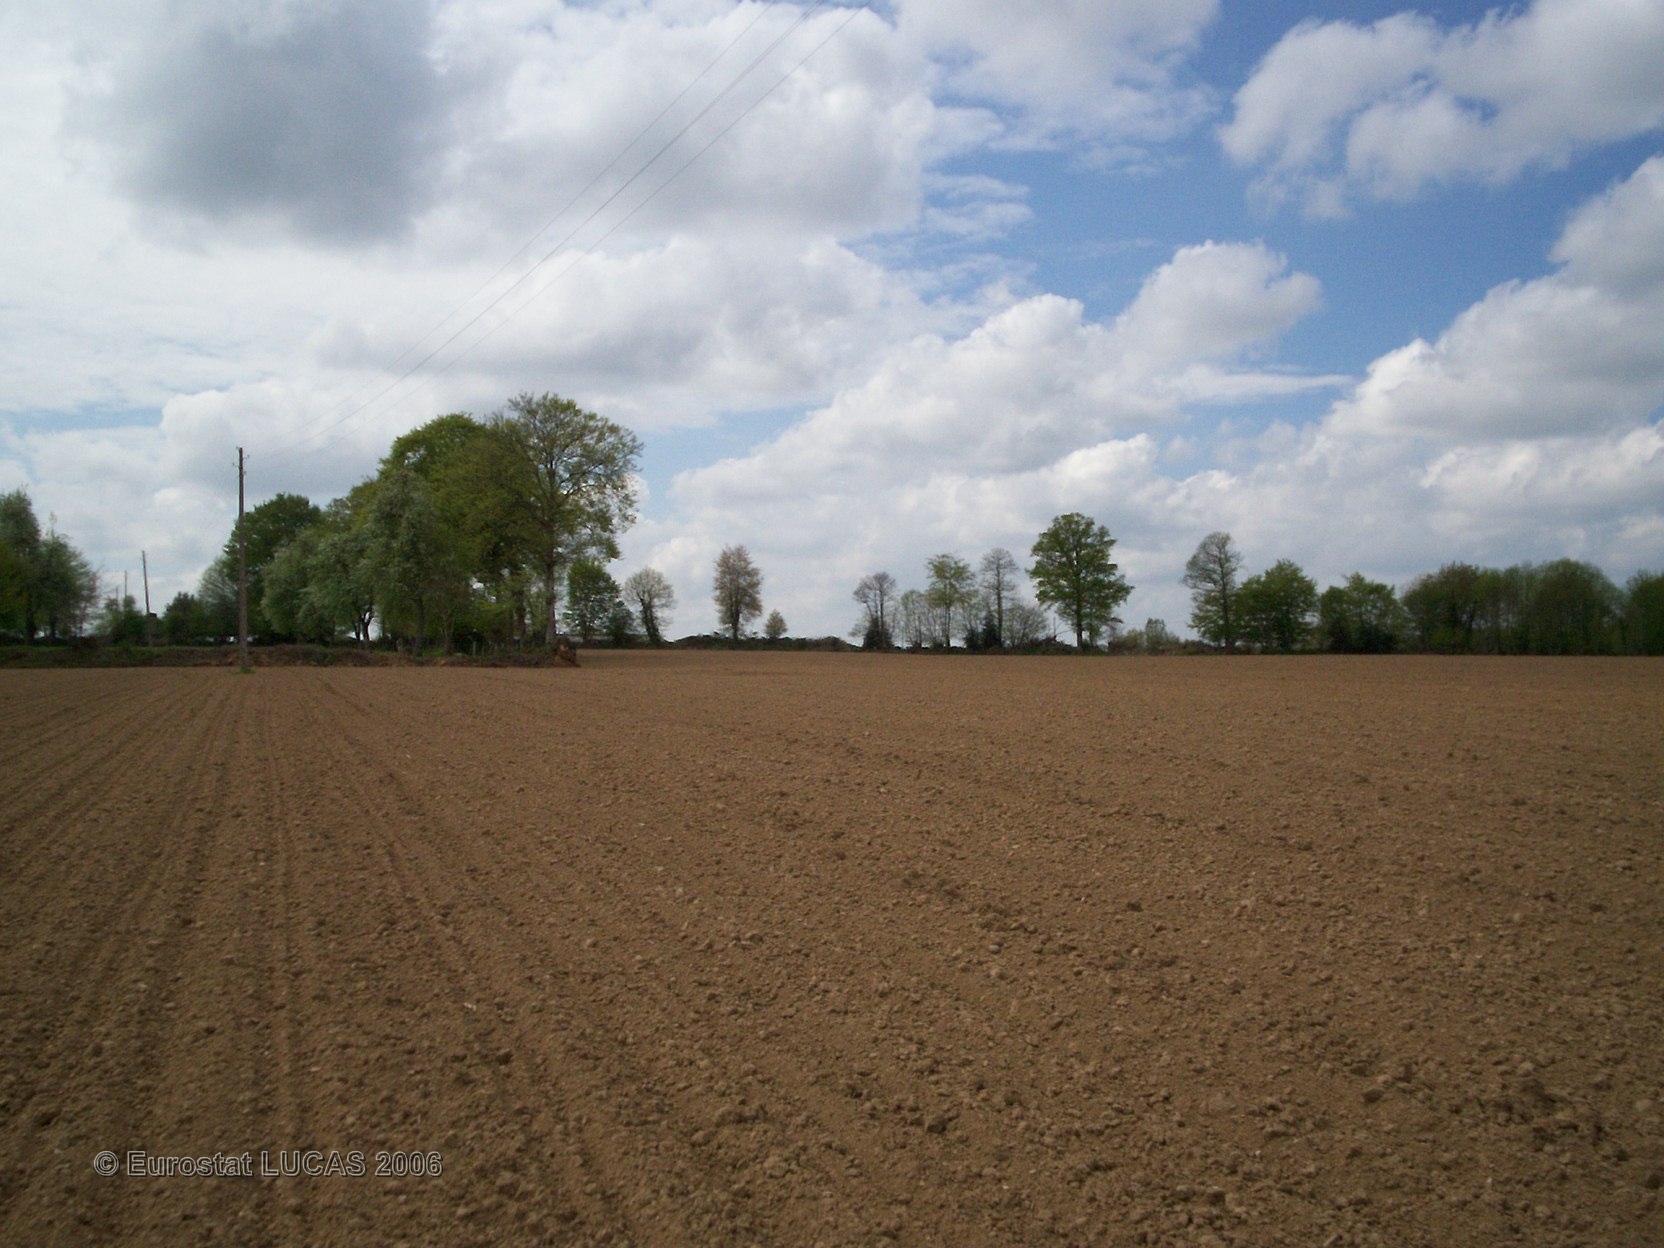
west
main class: Cropland
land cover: Maize
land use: Agriculture (excluding fallow land and kitchen gardens)
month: May
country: FR
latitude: 48.5694
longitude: -0.7303
